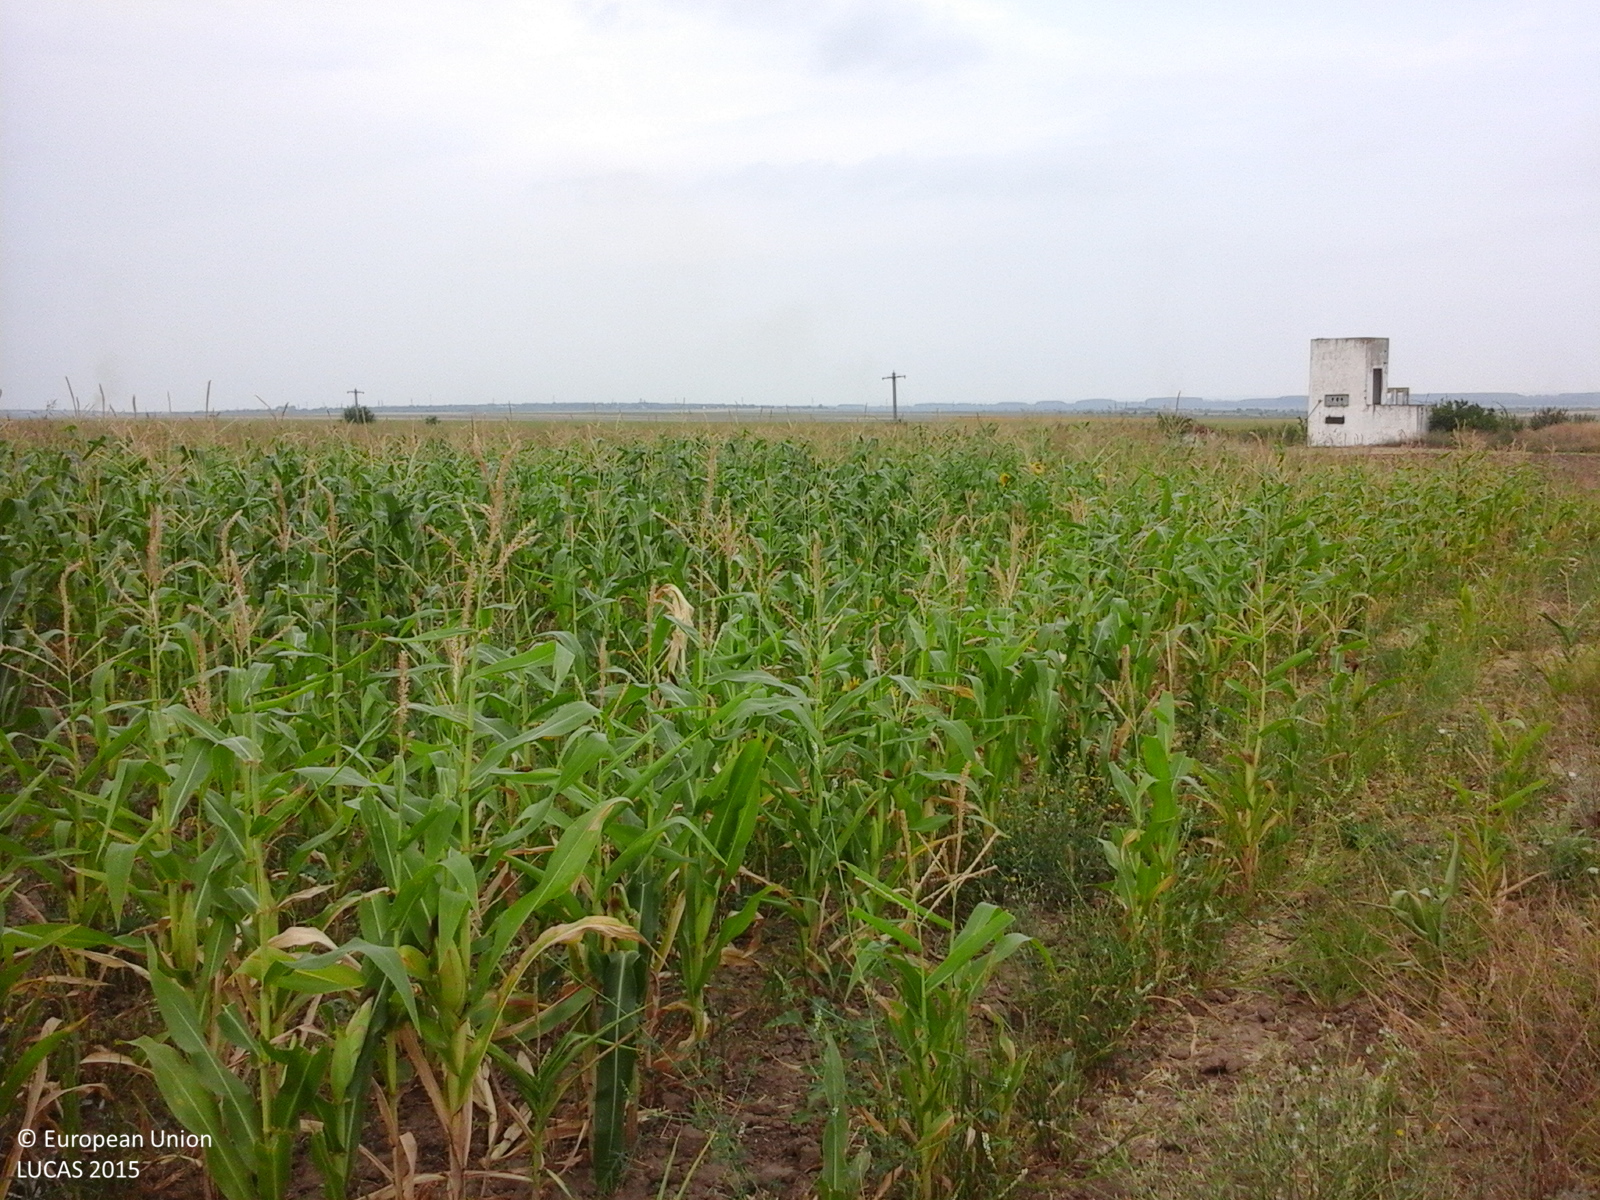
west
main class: Cropland
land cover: Maize
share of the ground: > 75 %
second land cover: Spontaneously vegetated surfaces
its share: > 75 %
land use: Agriculture (excluding fallow land and kitchen gardens)
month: July
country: RO
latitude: 44.9382
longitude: 28.2019
